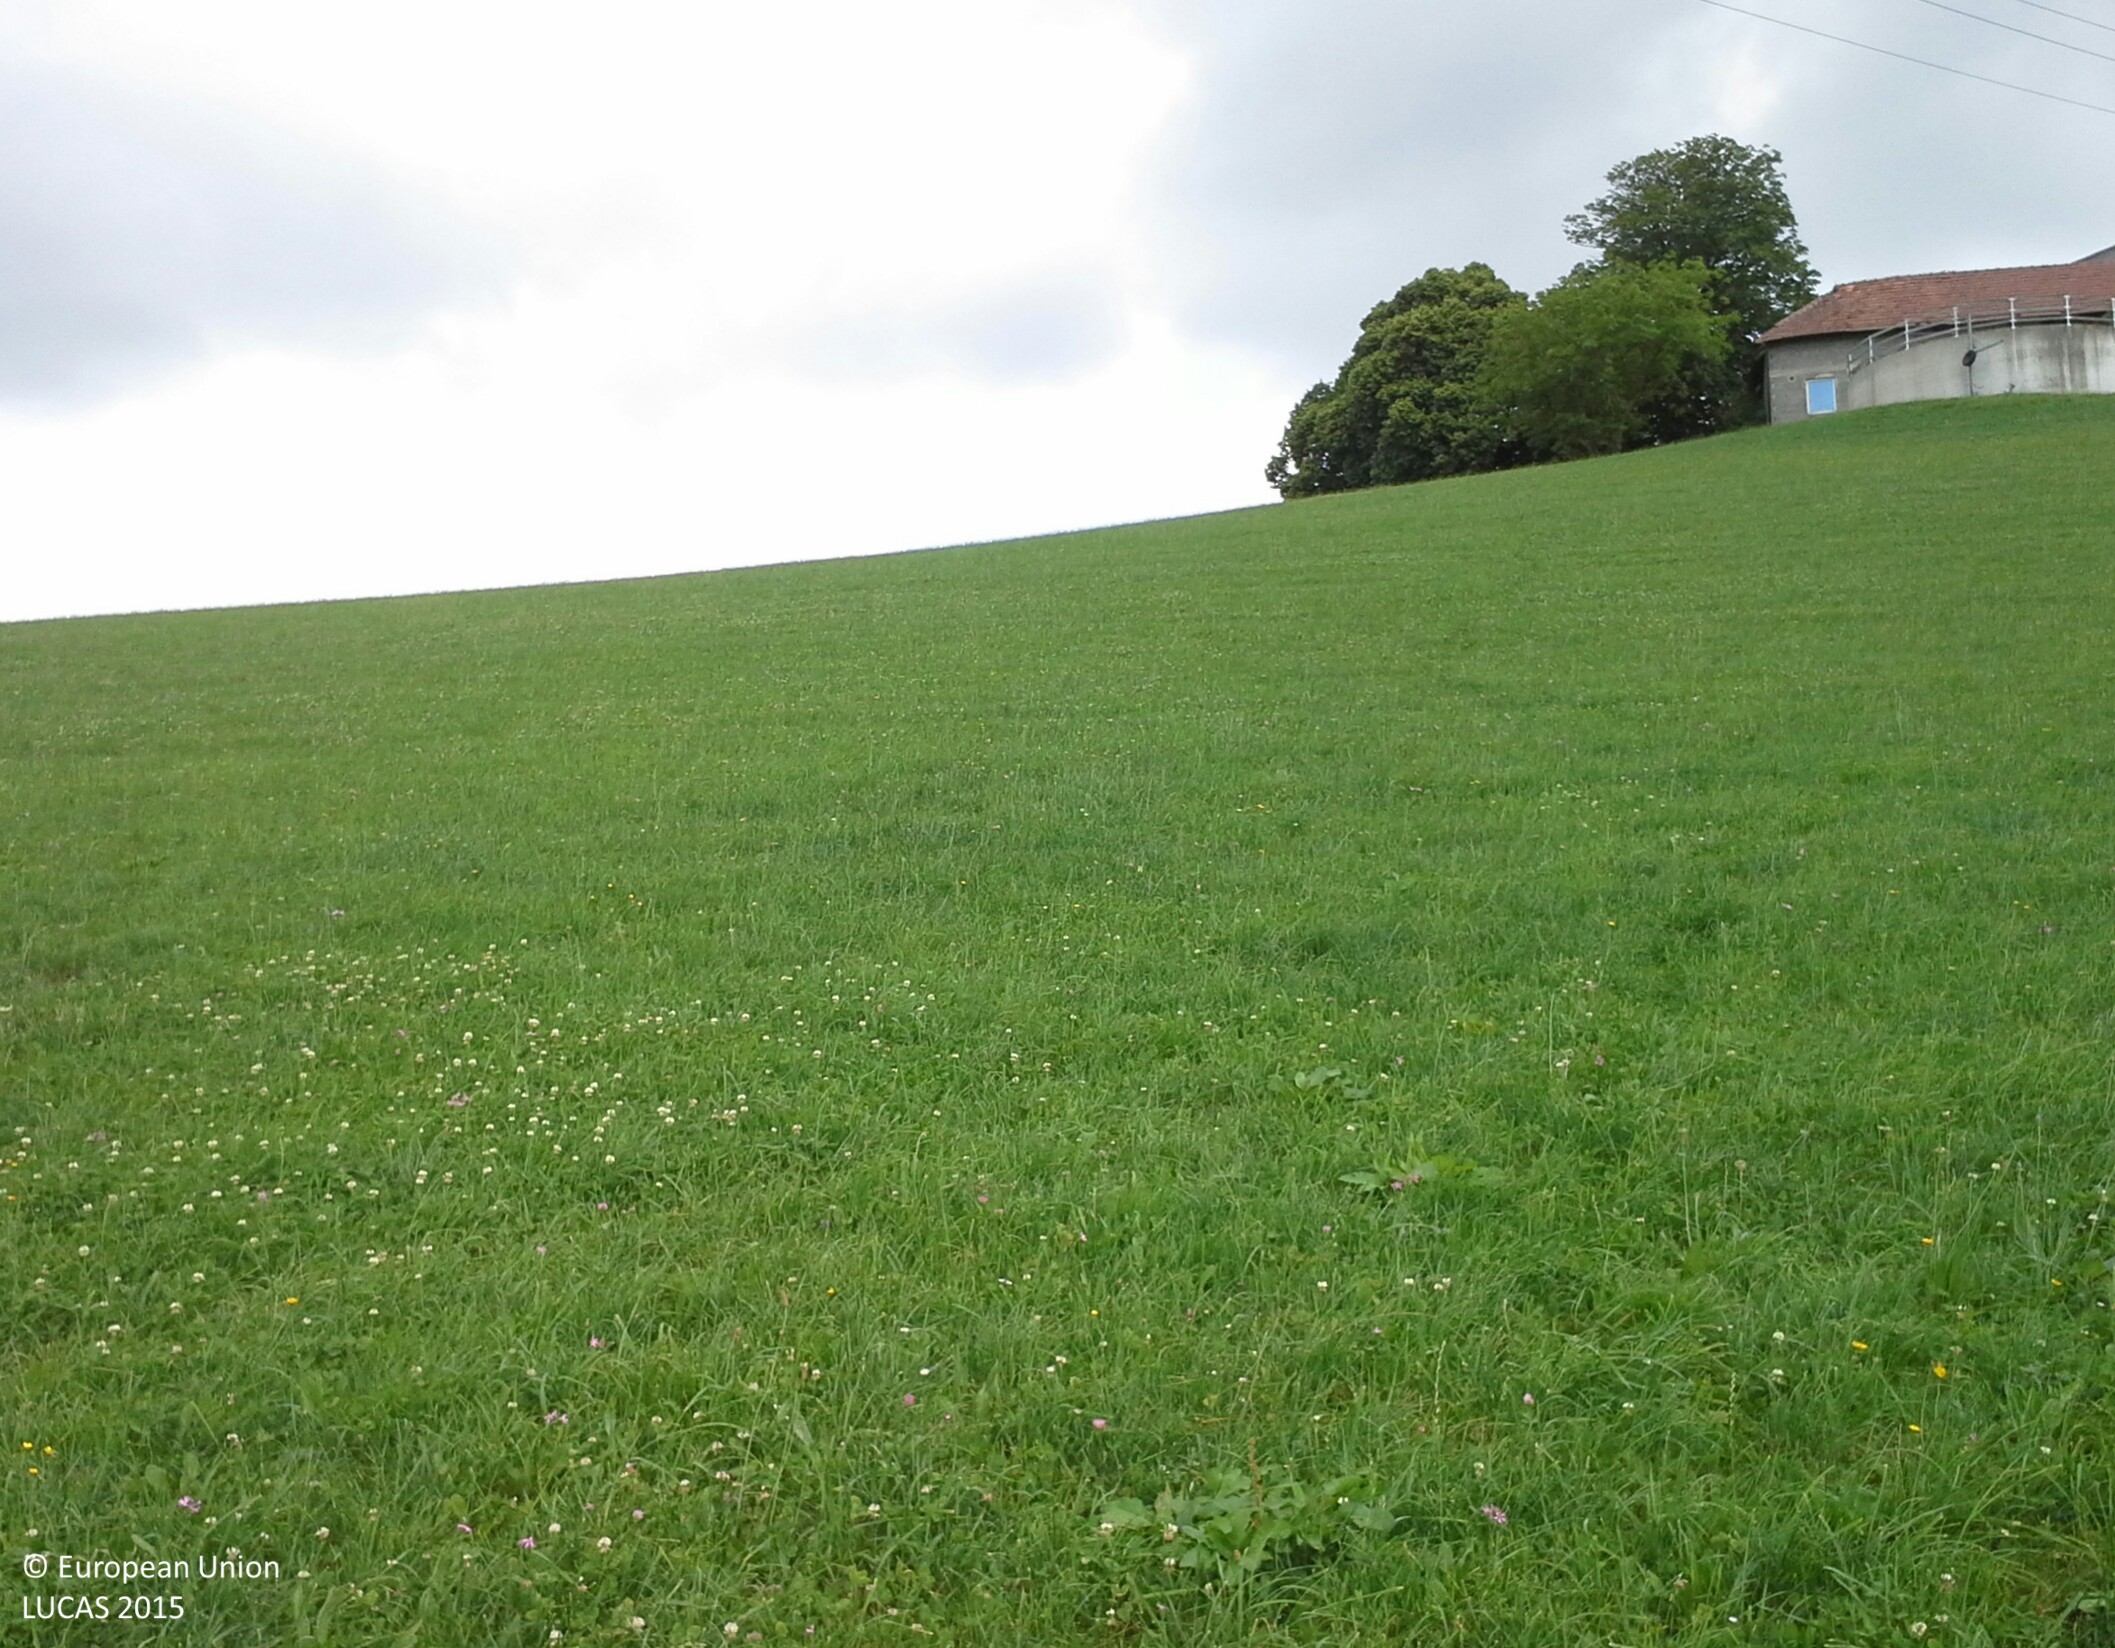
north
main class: Grassland
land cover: Grassland without tree/shrub cover
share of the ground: > 75 %
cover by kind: herbaceous plants 100 %
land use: Agriculture (excluding fallow land and kitchen gardens)
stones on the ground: > 50 %
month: July
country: AT
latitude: 47.9656
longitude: 14.5941
